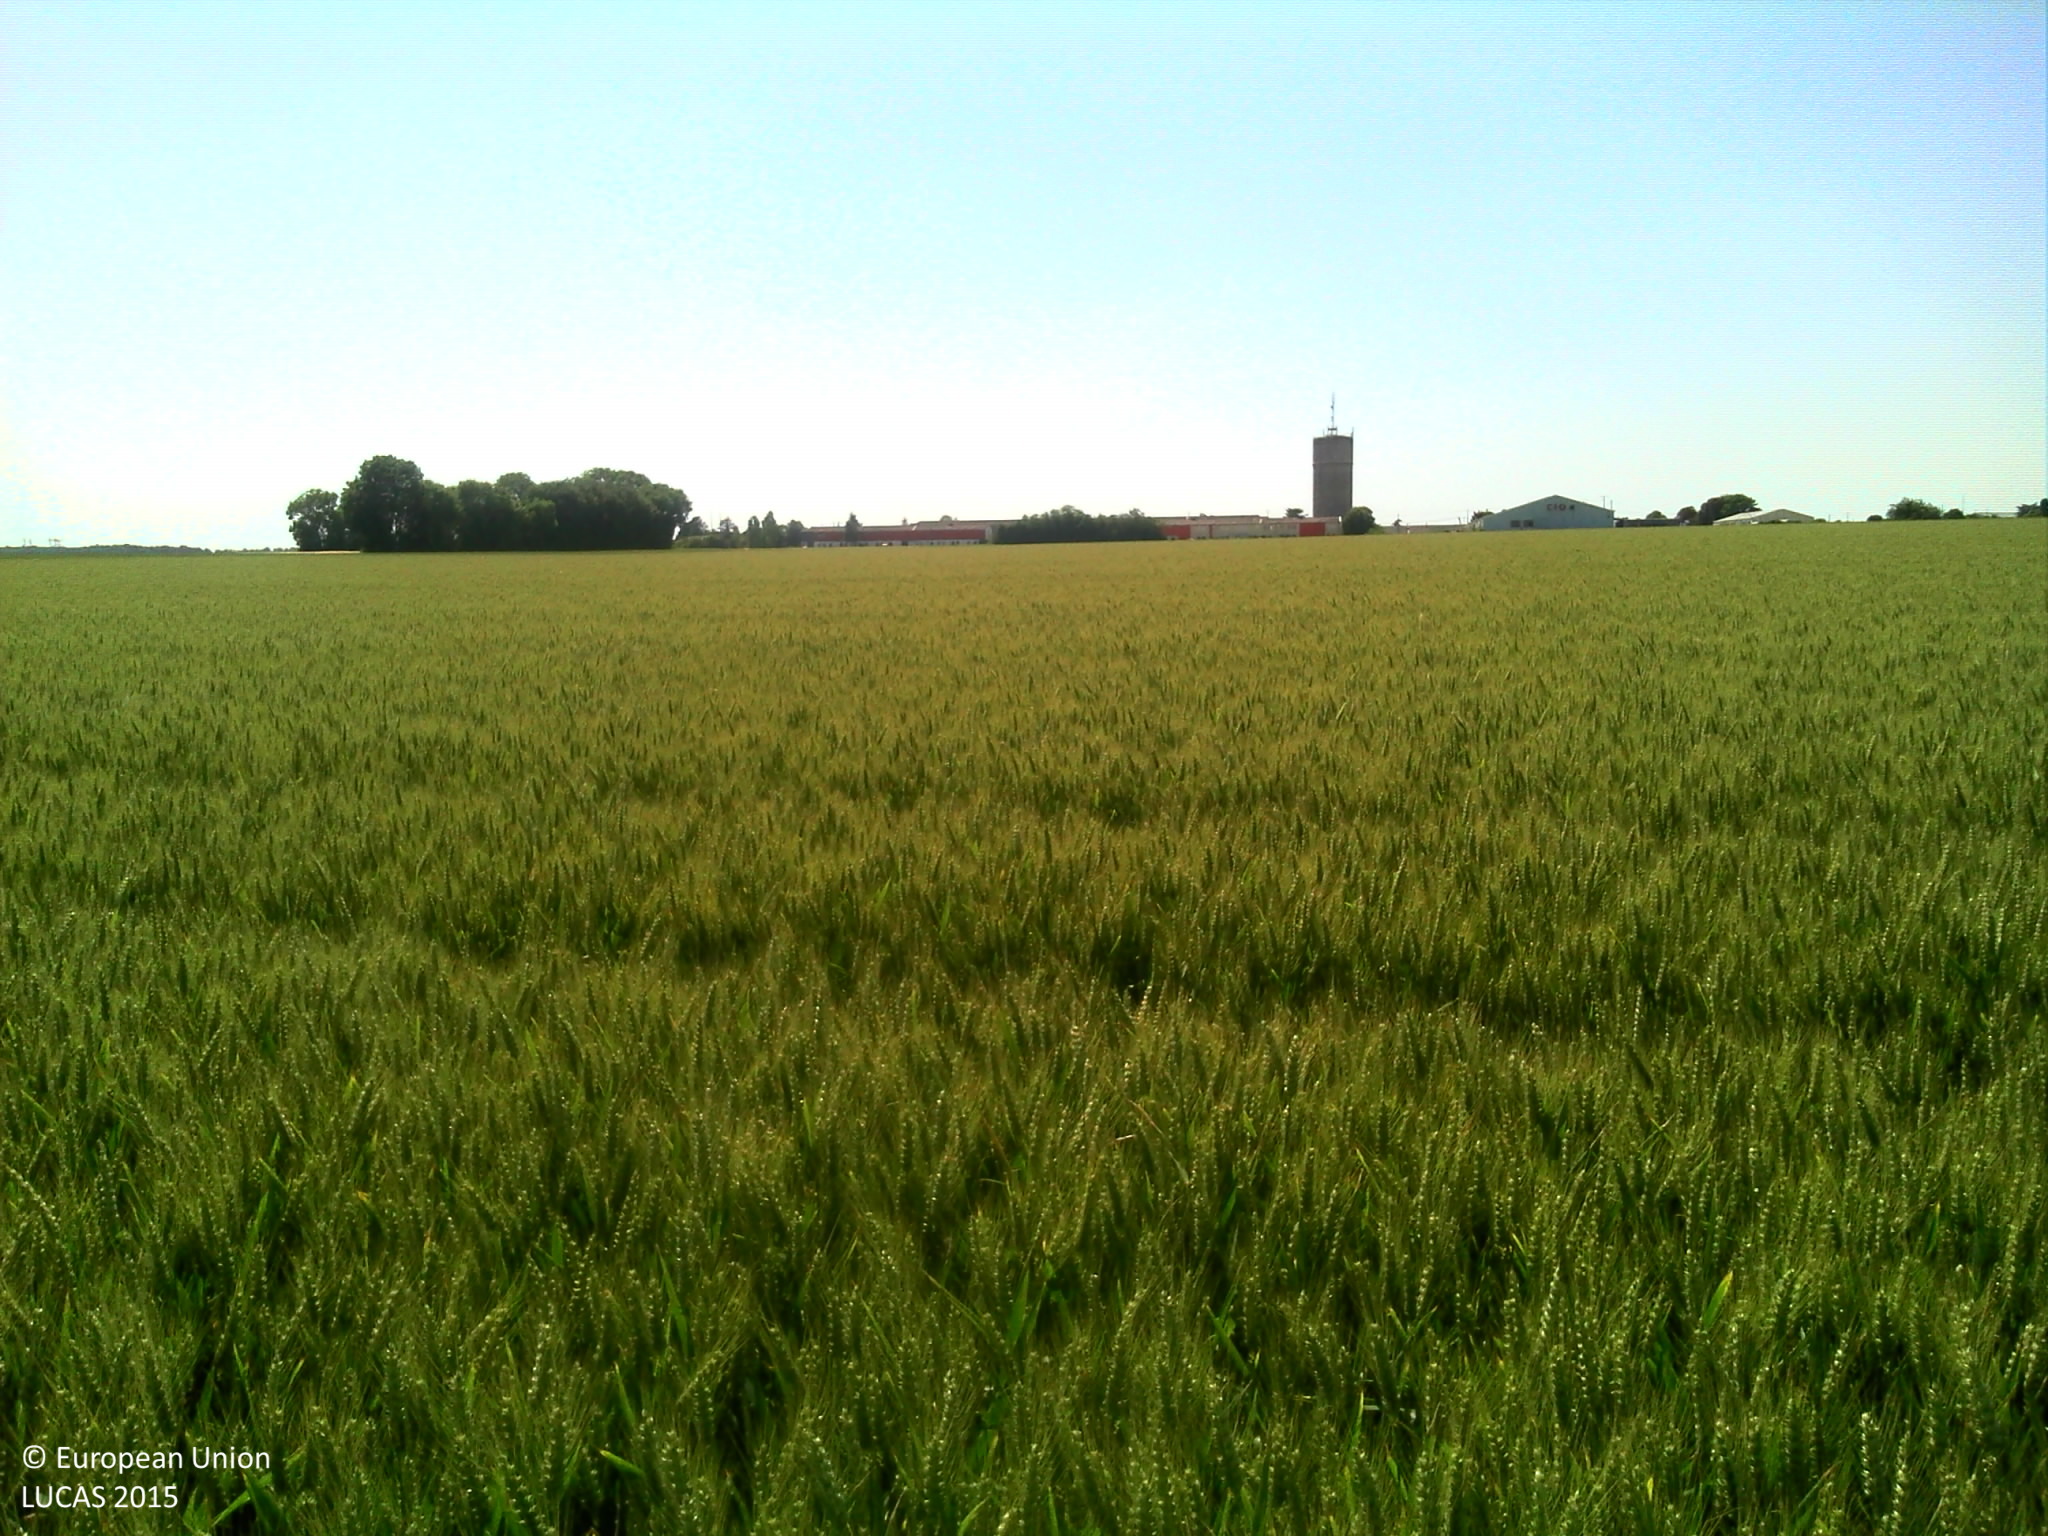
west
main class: Cropland
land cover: Durum wheat
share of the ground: > 75 %
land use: Agriculture (excluding fallow land and kitchen gardens)
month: June
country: FR
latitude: 46.1130
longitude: -0.9628
